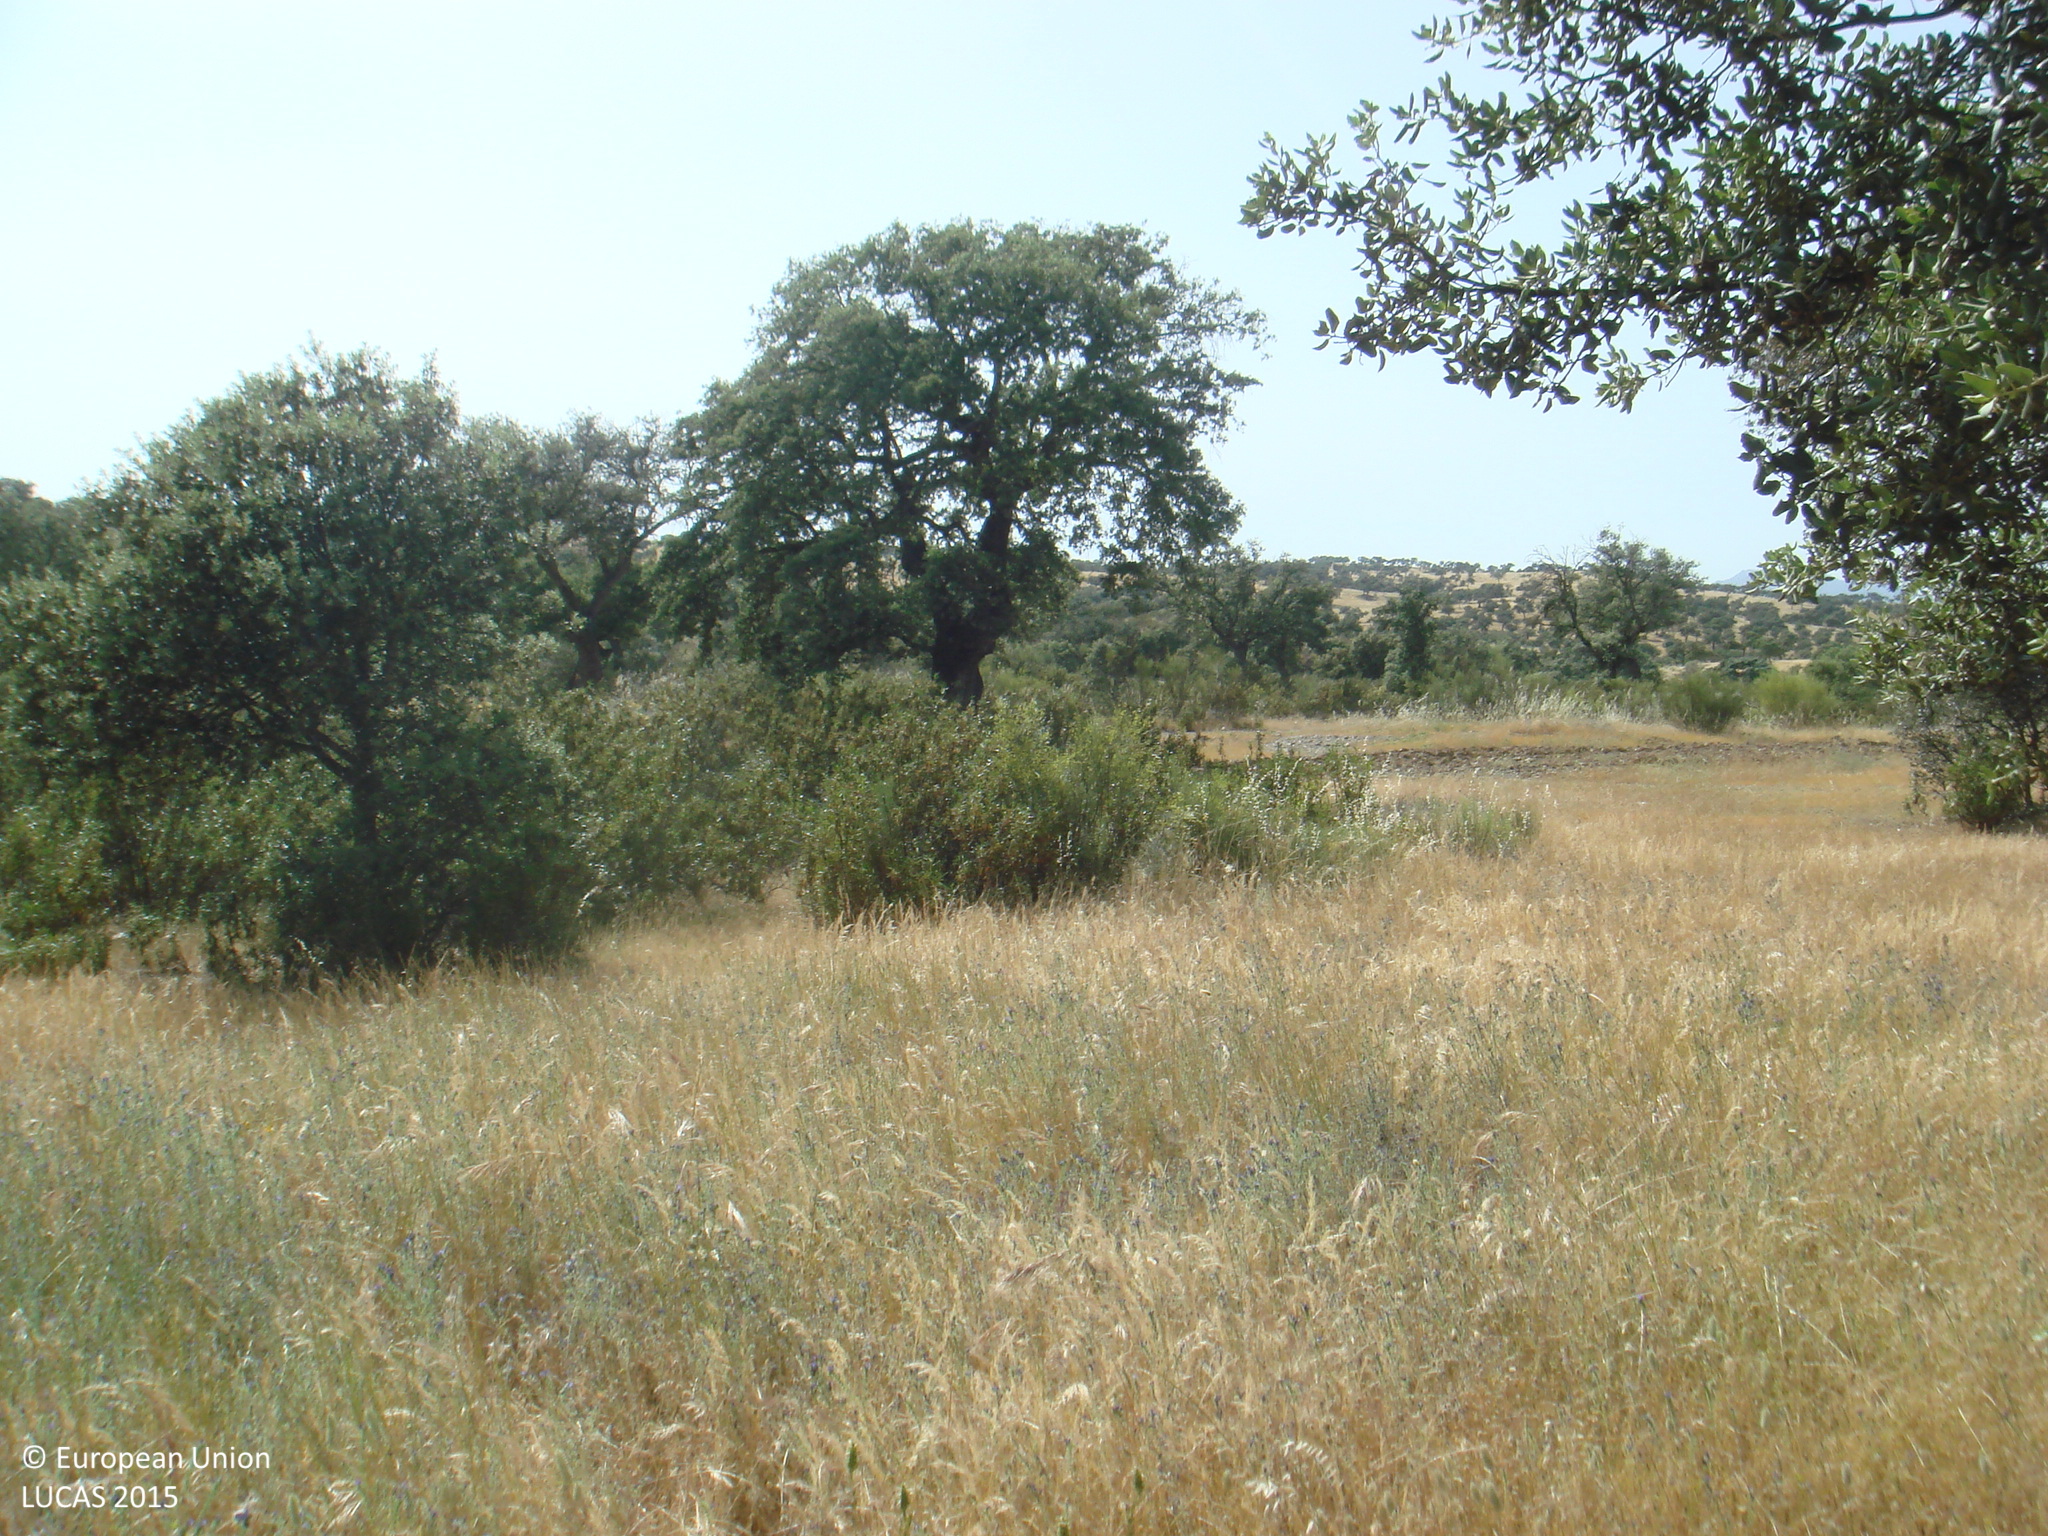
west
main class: Woodland
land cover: Broadleaved woodland
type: broadleaved evergreen forest
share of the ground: 25 - 50 %
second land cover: Spontaneously vegetated surfaces
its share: > 75 %
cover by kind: herbaceous plants 50 %, broadleaved forest trees 40 %, shrubs 10 %
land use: Forestry
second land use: Agriculture (excluding fallow land and kitchen gardens)
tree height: > 5 m
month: May
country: ES
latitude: 38.5084
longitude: -4.7137
